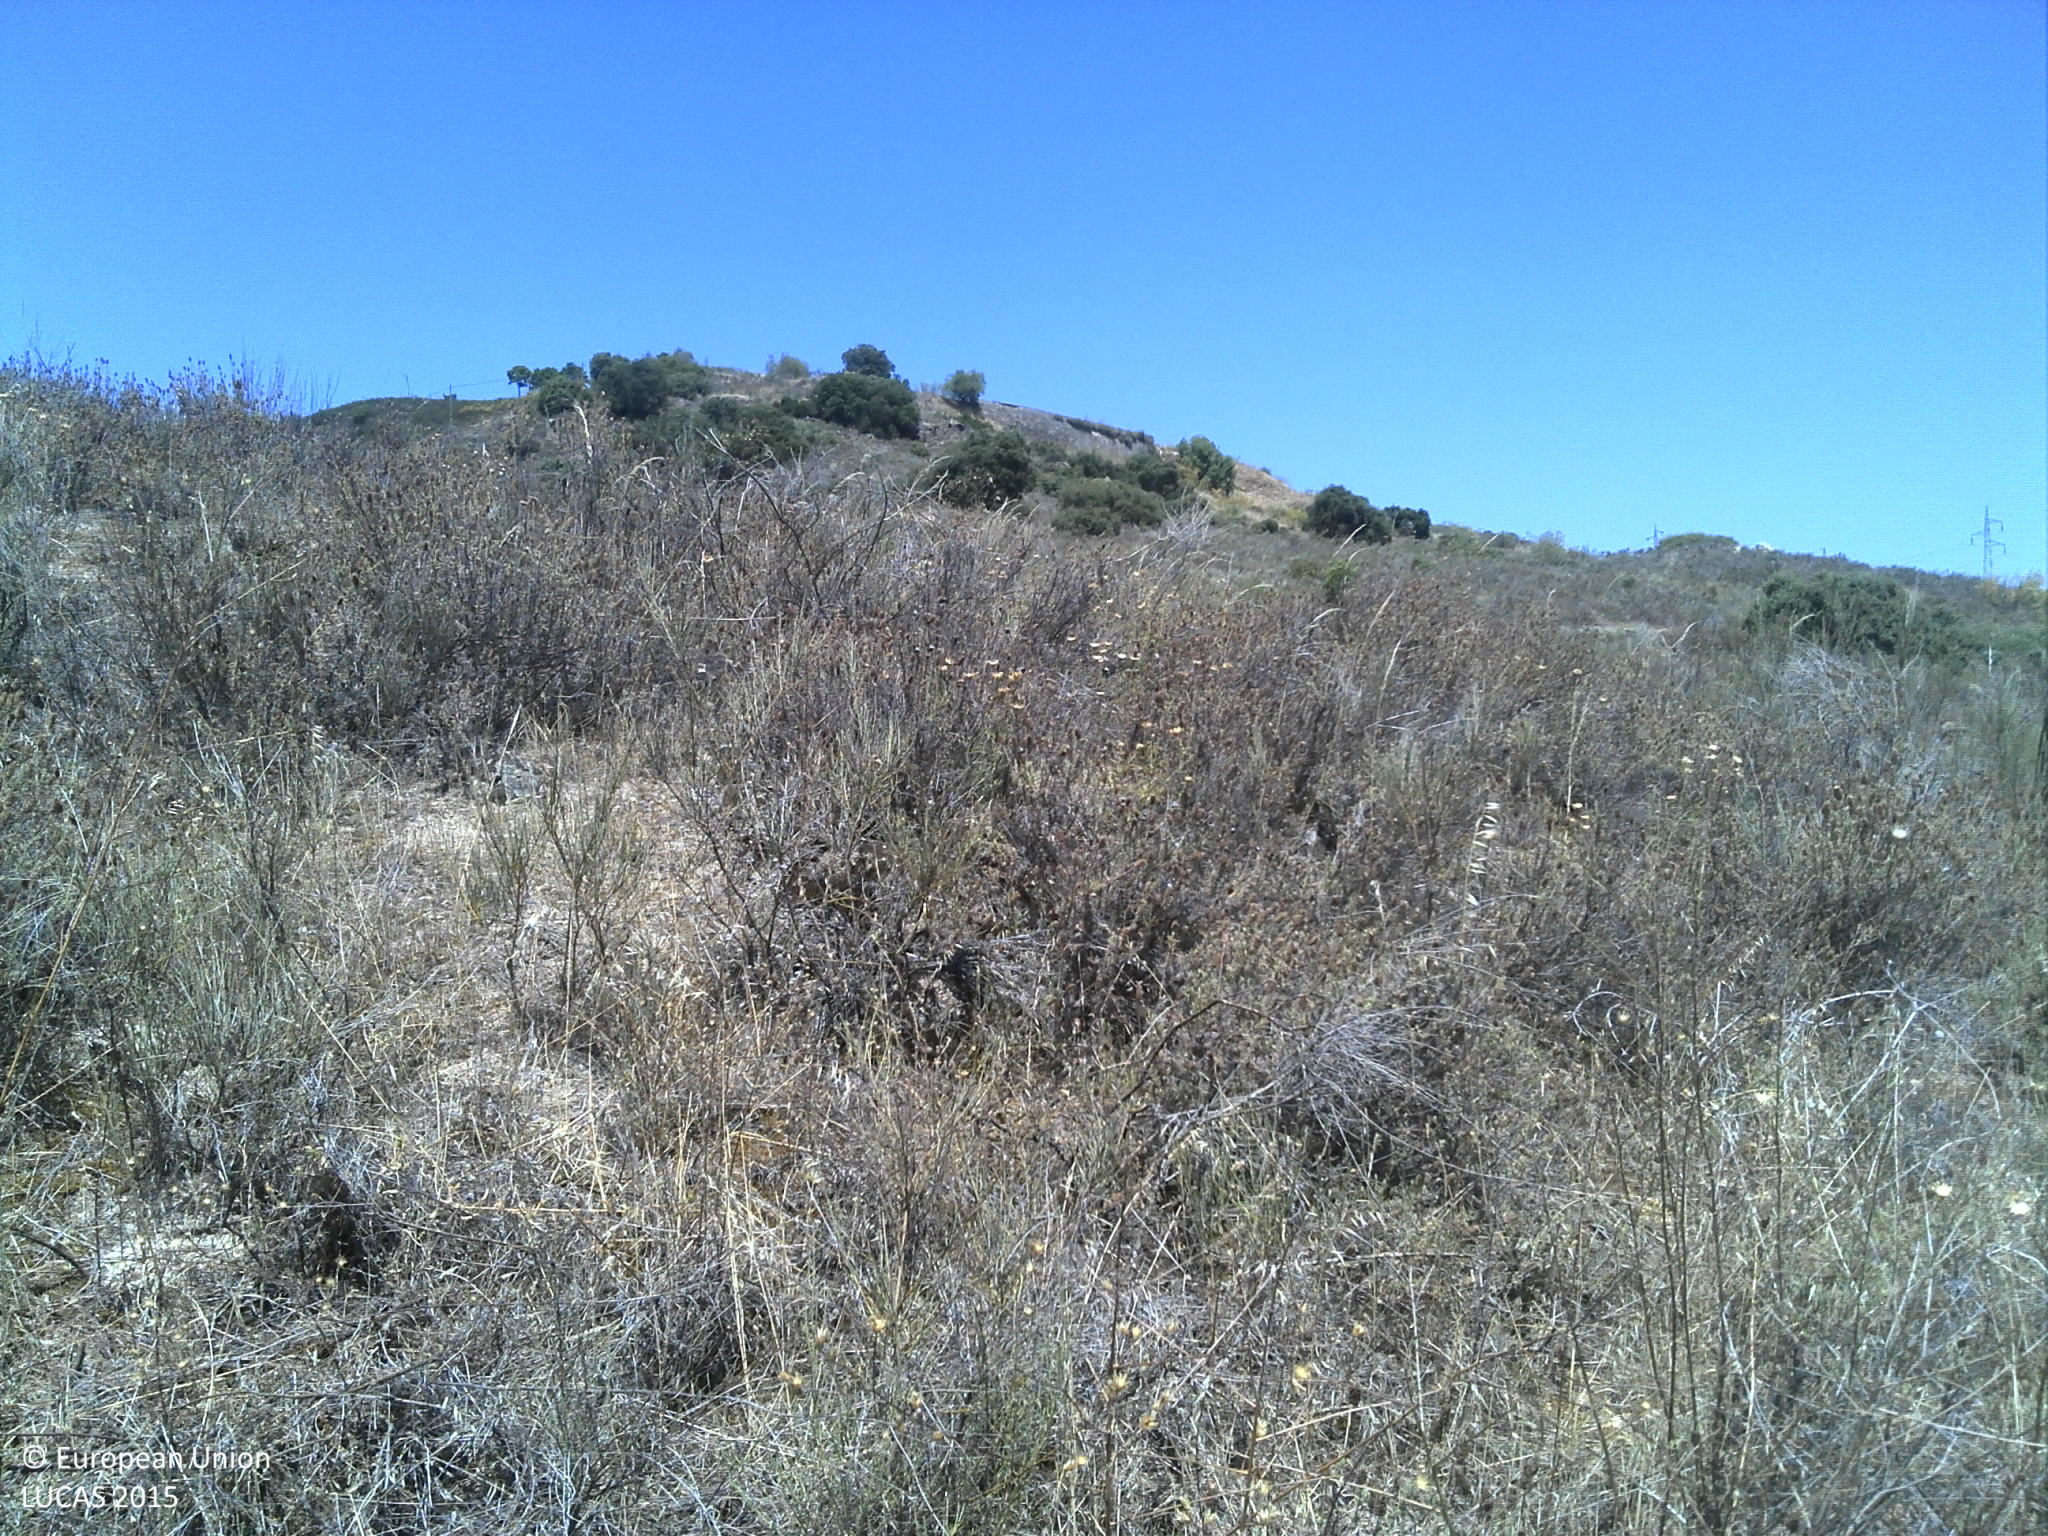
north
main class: Shrubland
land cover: Shrubland without tree cover
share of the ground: > 75 %
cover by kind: shrubs 100 %
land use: Semi-natural and natural areas not in use
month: July
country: PT
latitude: 41.3787
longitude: -7.0575
